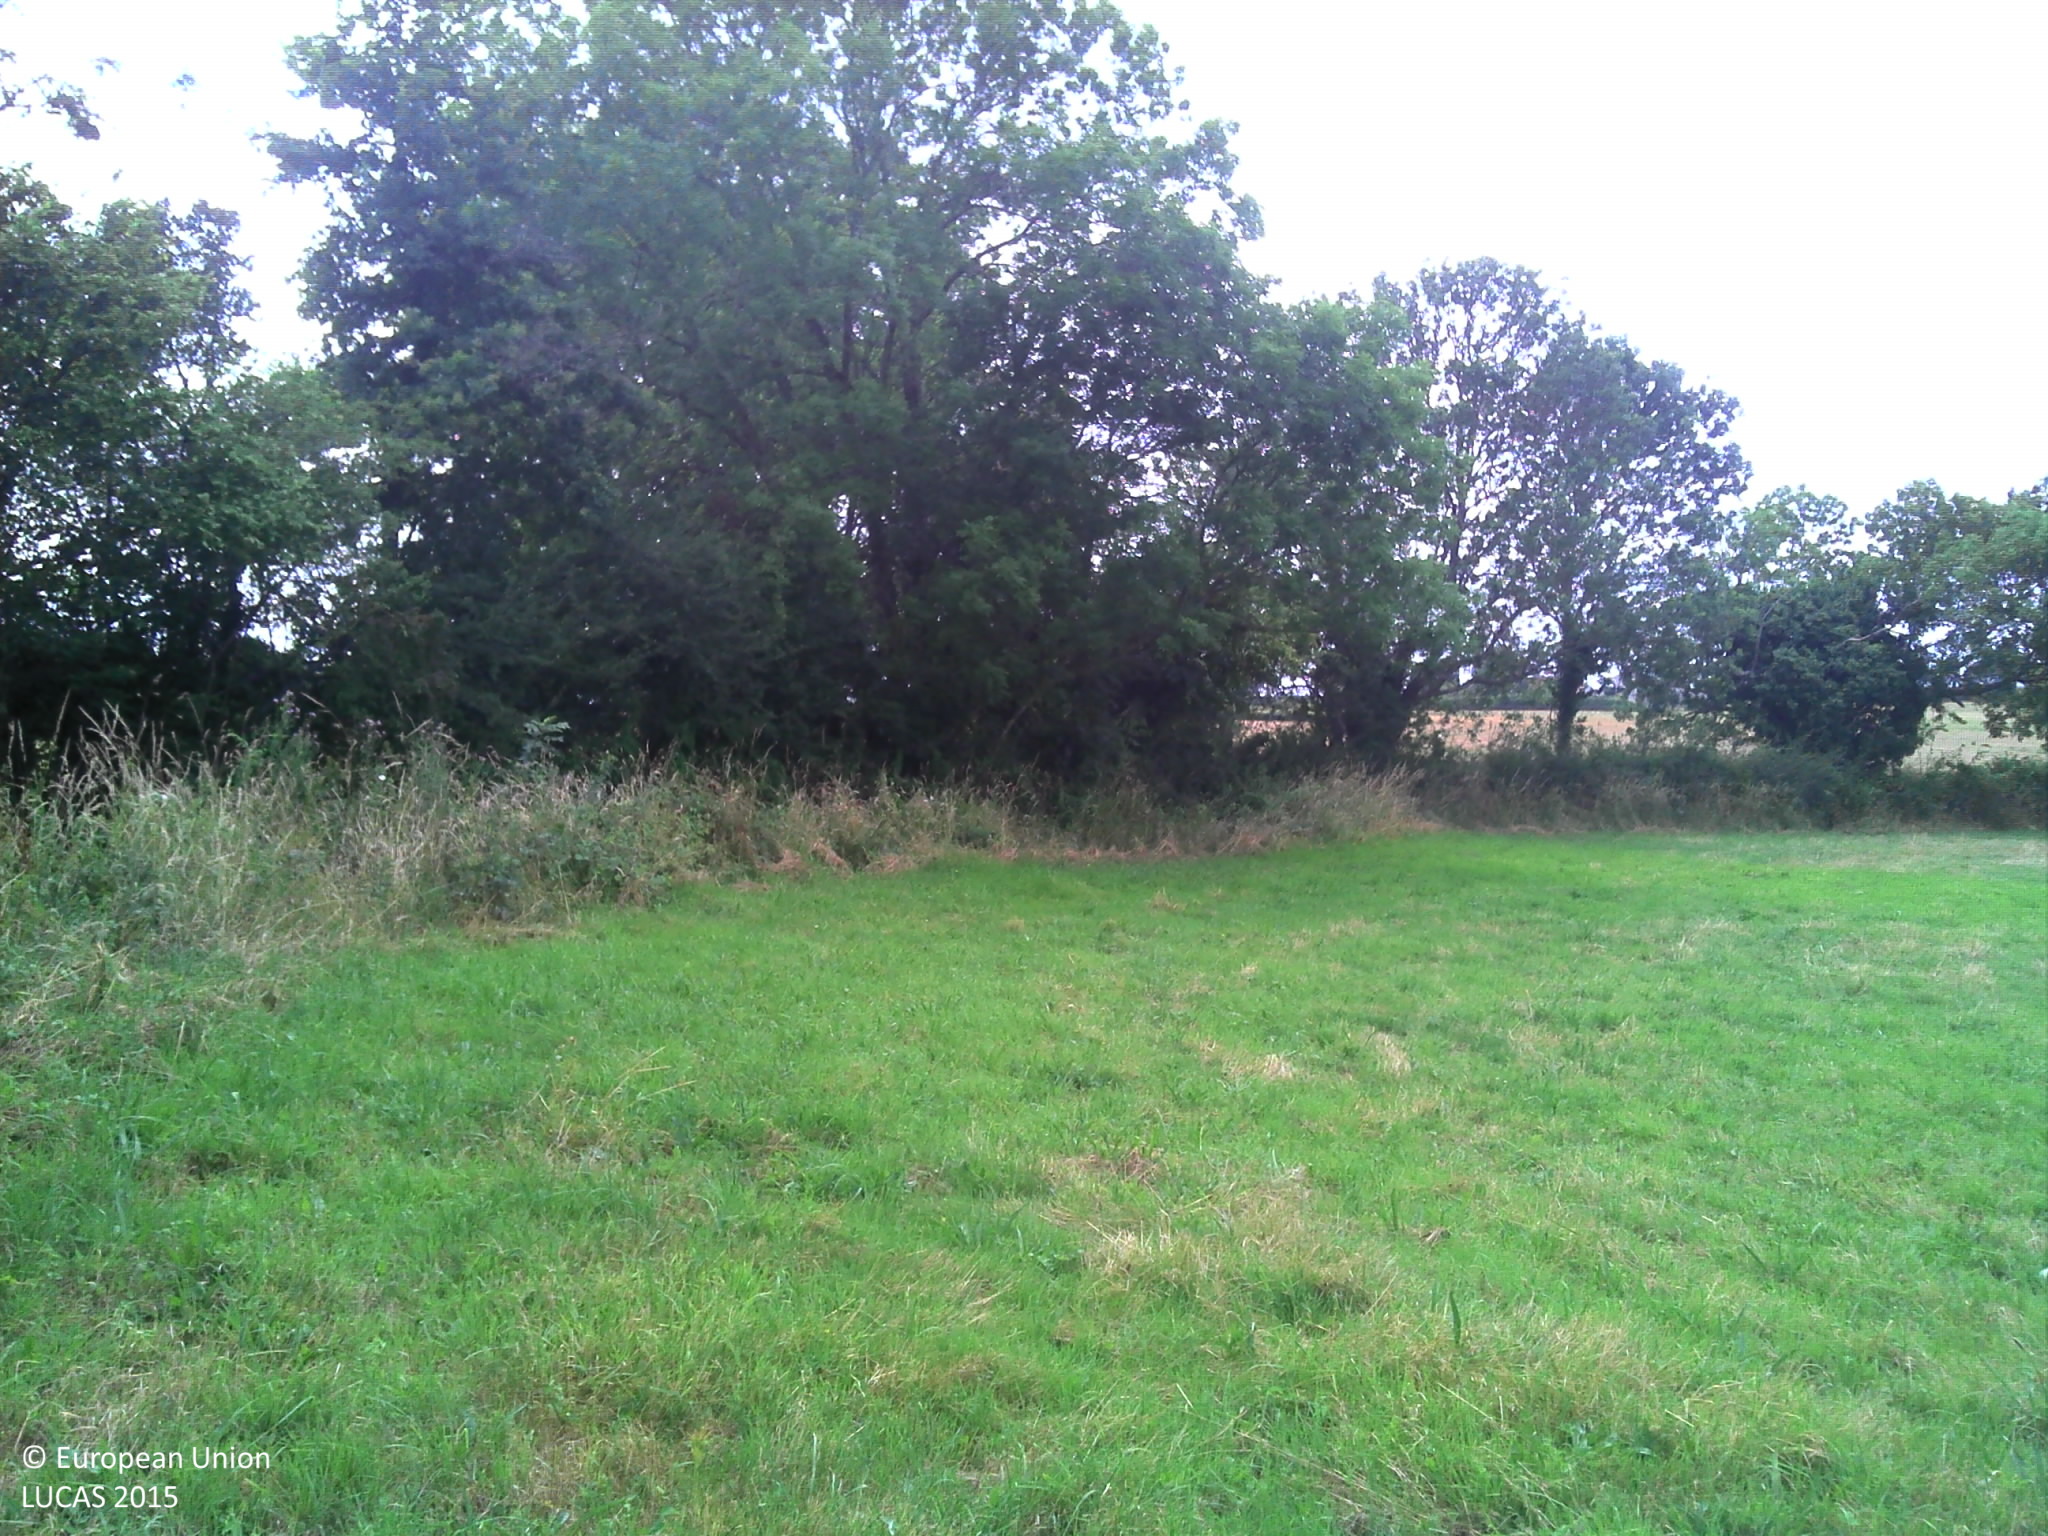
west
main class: Grassland
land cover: Grassland without tree/shrub cover
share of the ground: > 75 %
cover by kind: herbaceous plants 100 %
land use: Agriculture (excluding fallow land and kitchen gardens)
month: July
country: FR
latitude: 46.4492
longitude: 3.0327
